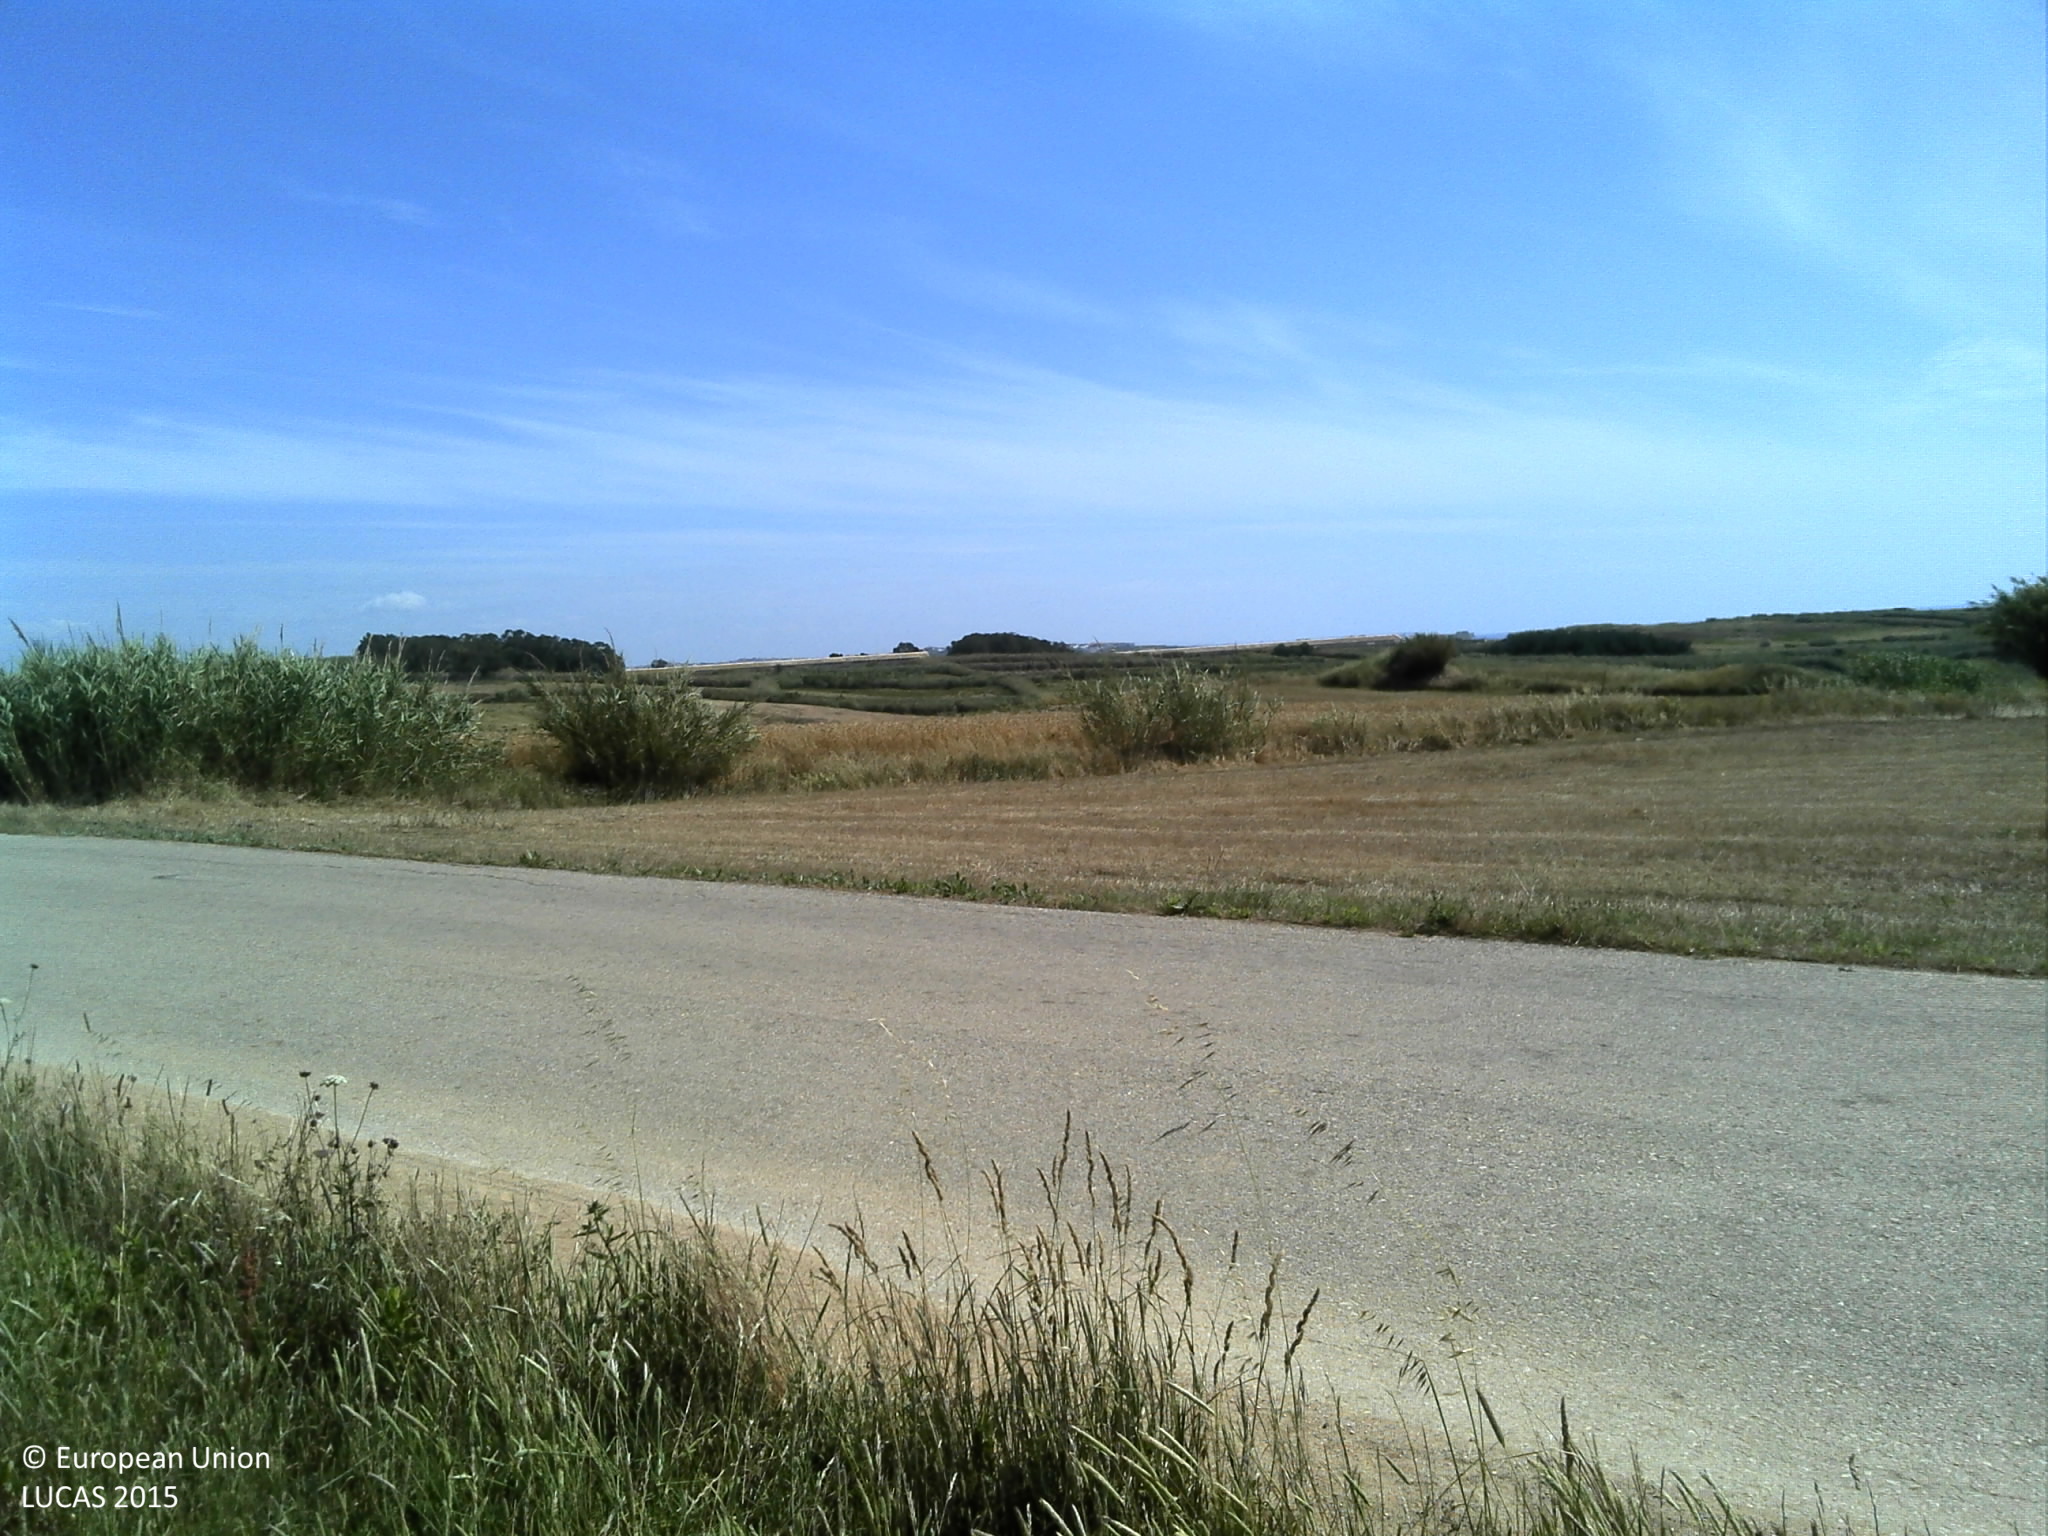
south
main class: Cropland
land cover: Common wheat
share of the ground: > 75 %
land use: Agriculture (excluding fallow land and kitchen gardens)
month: June
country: PT
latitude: 39.2889
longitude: -9.3267
